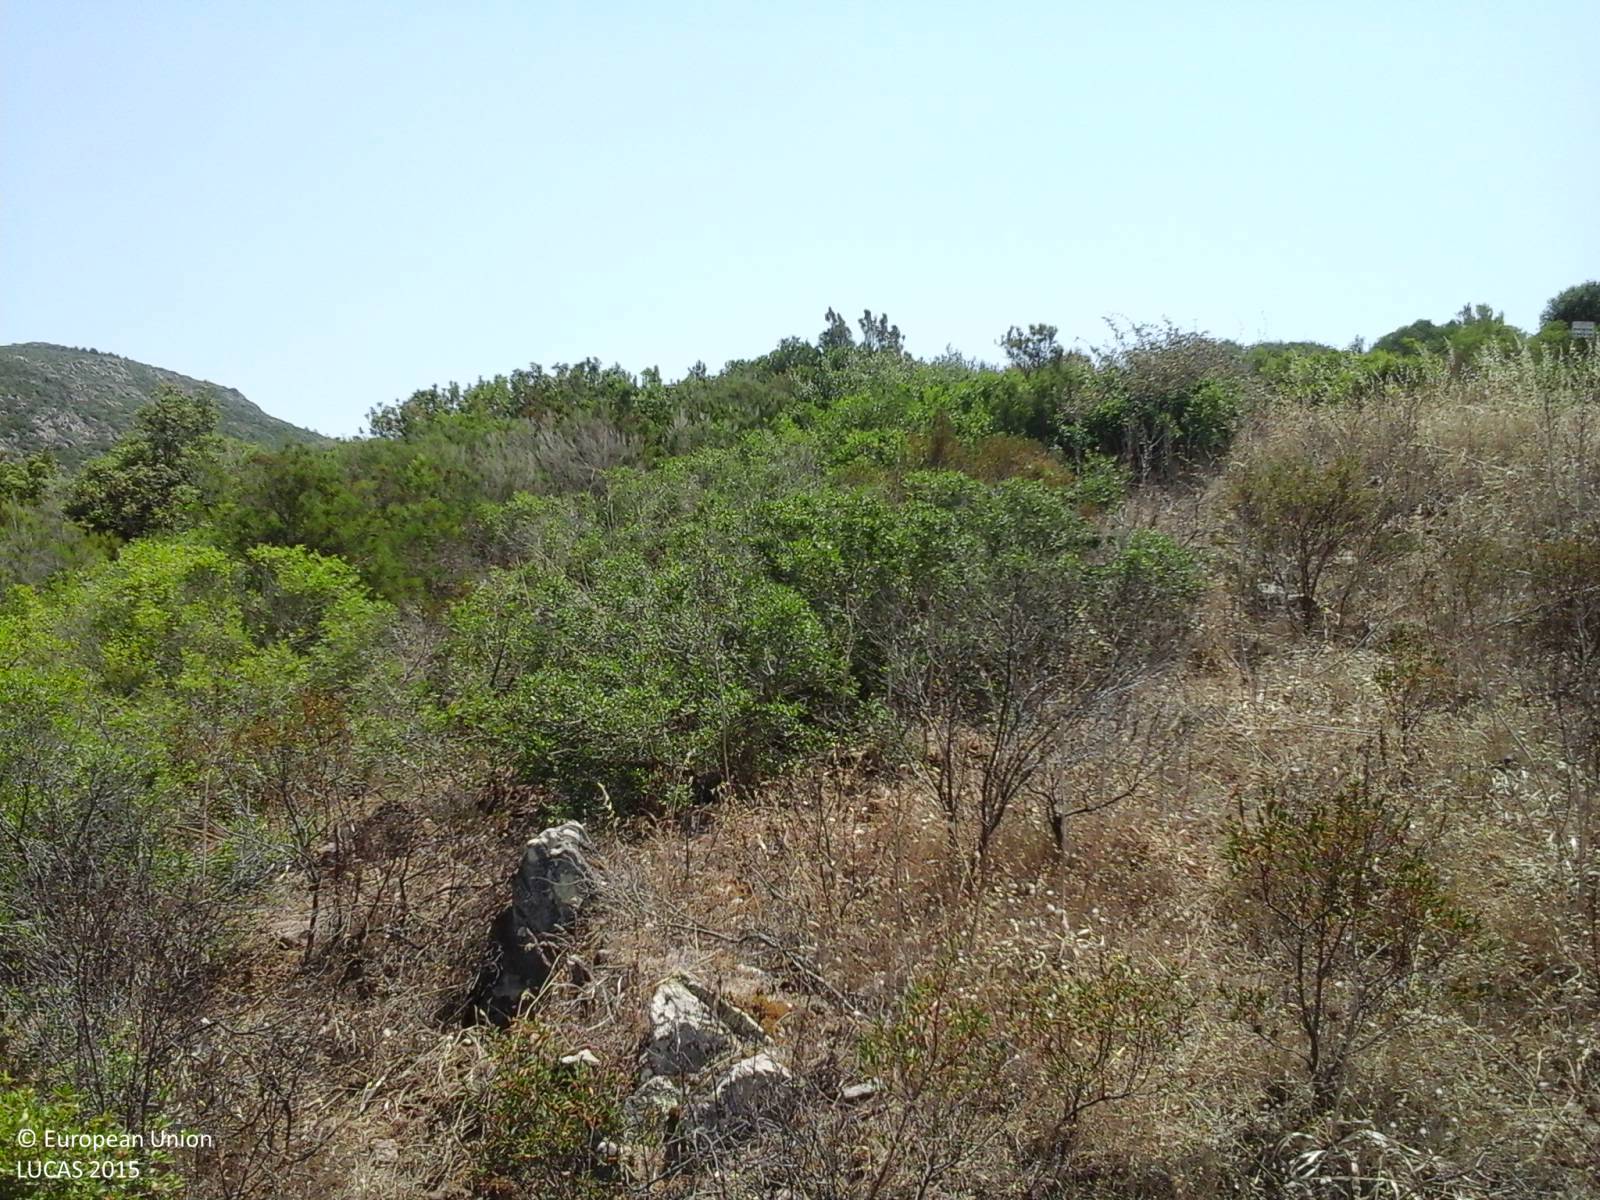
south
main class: Shrubland
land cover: Shrubland with sparse tree cover
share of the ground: > 75 %
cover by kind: shrubs 95 %, broadleaved forest trees 5 %
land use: Semi-natural and natural areas not in use
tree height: < 5 m
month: July
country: IT
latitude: 39.9522
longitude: 8.8010
